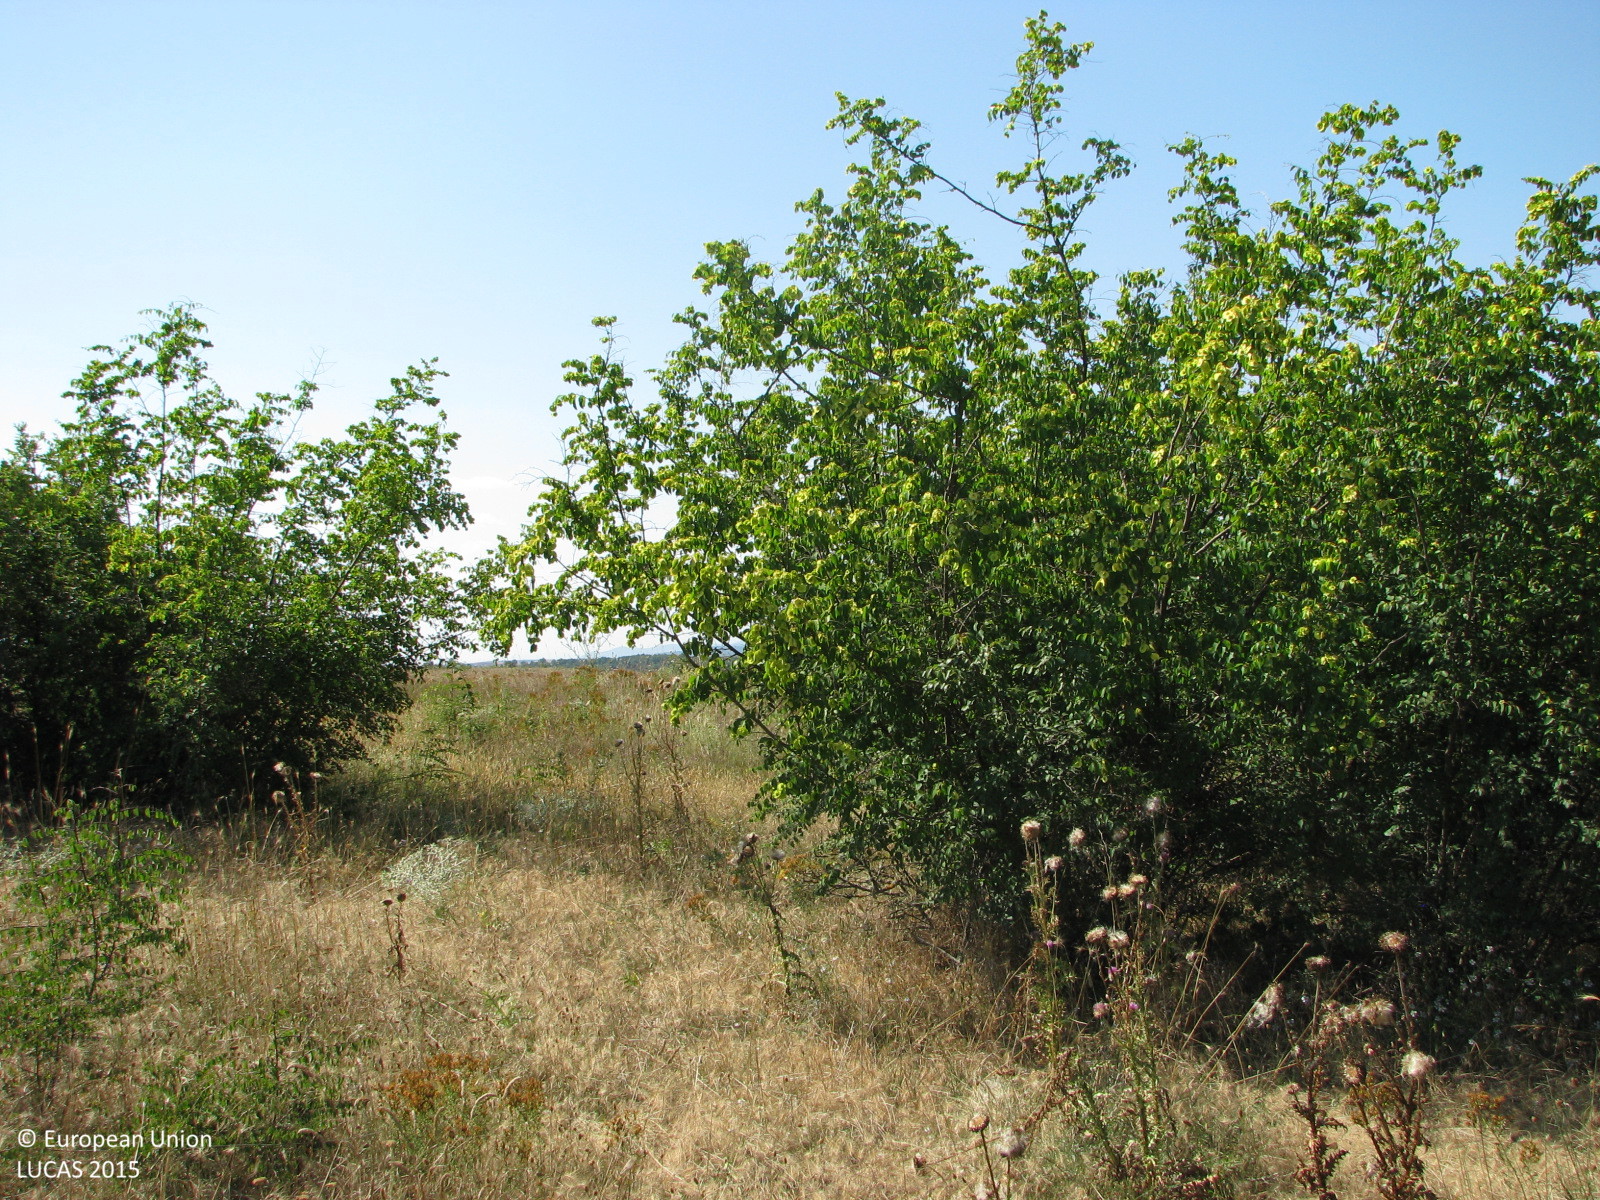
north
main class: Shrubland
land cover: Shrubland without tree cover
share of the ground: > 75 %
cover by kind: herbaceous plants 80 %, shrubs 20 %
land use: Semi-natural and natural areas not in use
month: July
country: BG
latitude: 42.2766
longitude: 26.8678
